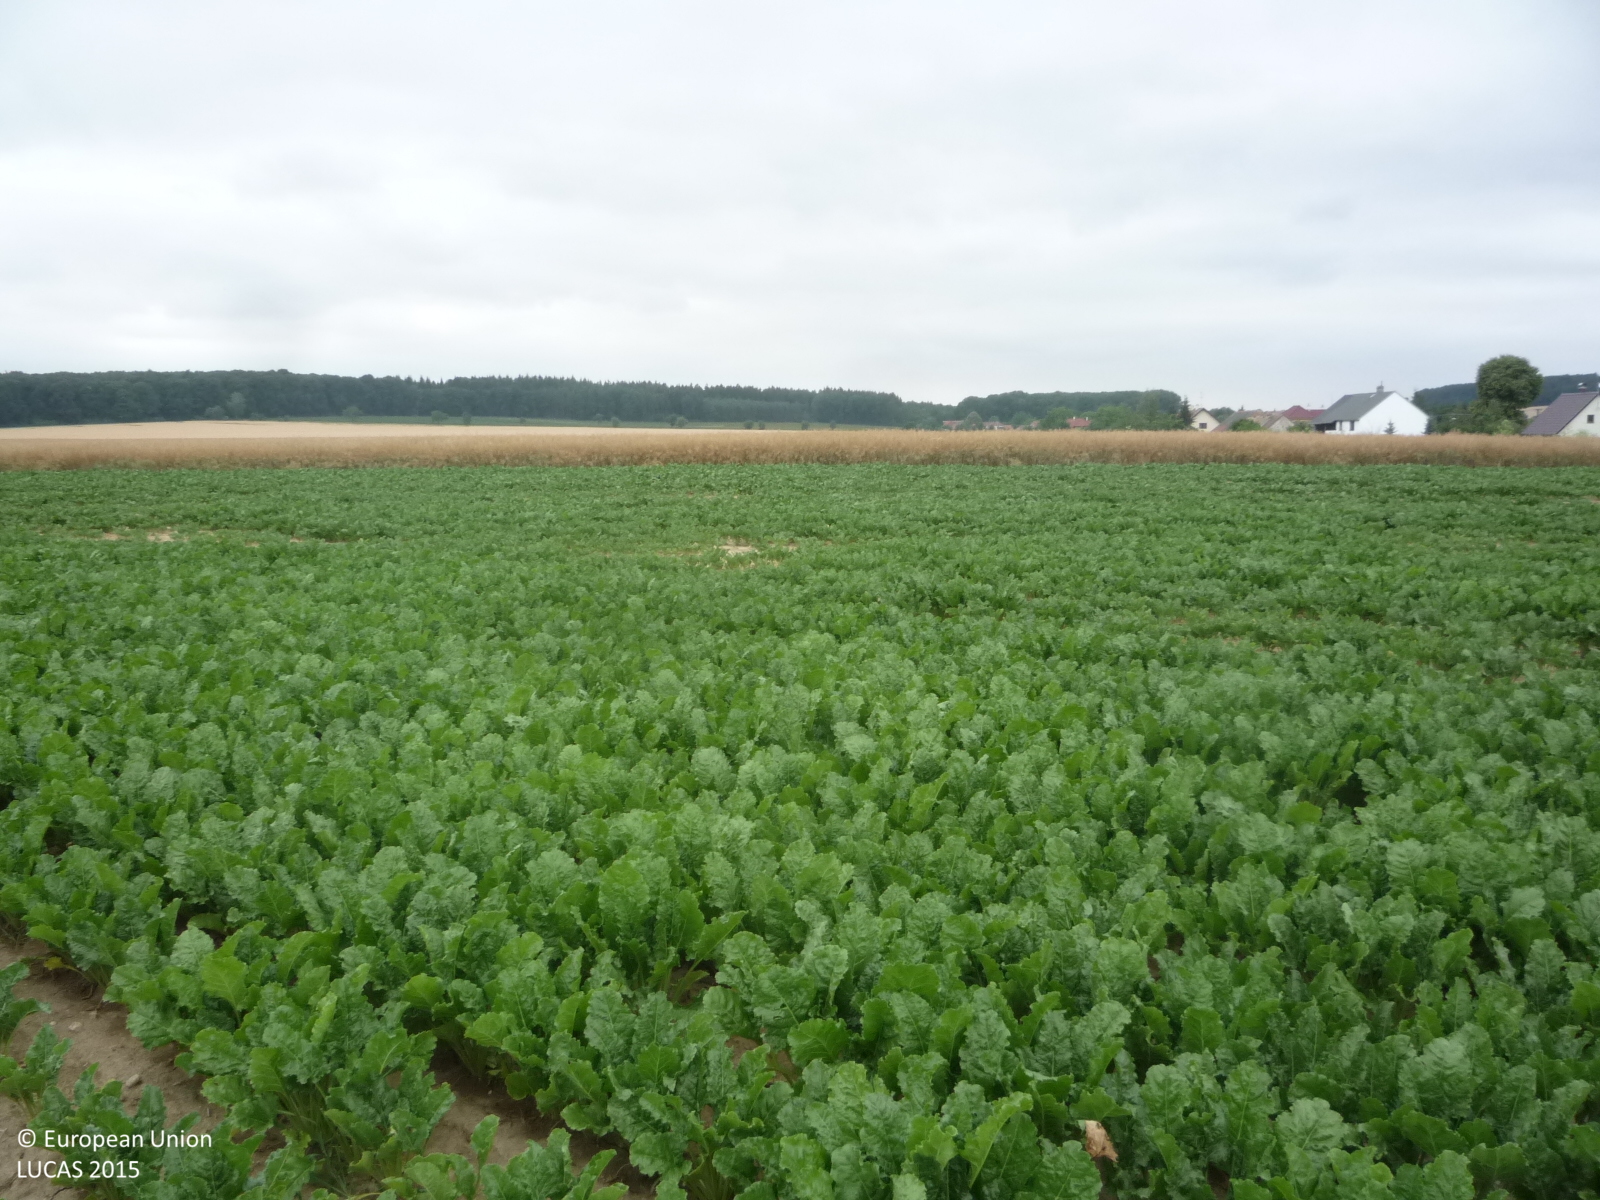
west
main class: Cropland
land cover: Sugar beet
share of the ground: > 75 %
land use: Agriculture (excluding fallow land and kitchen gardens)
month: July
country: CZ
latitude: 50.2050
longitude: 15.6791
